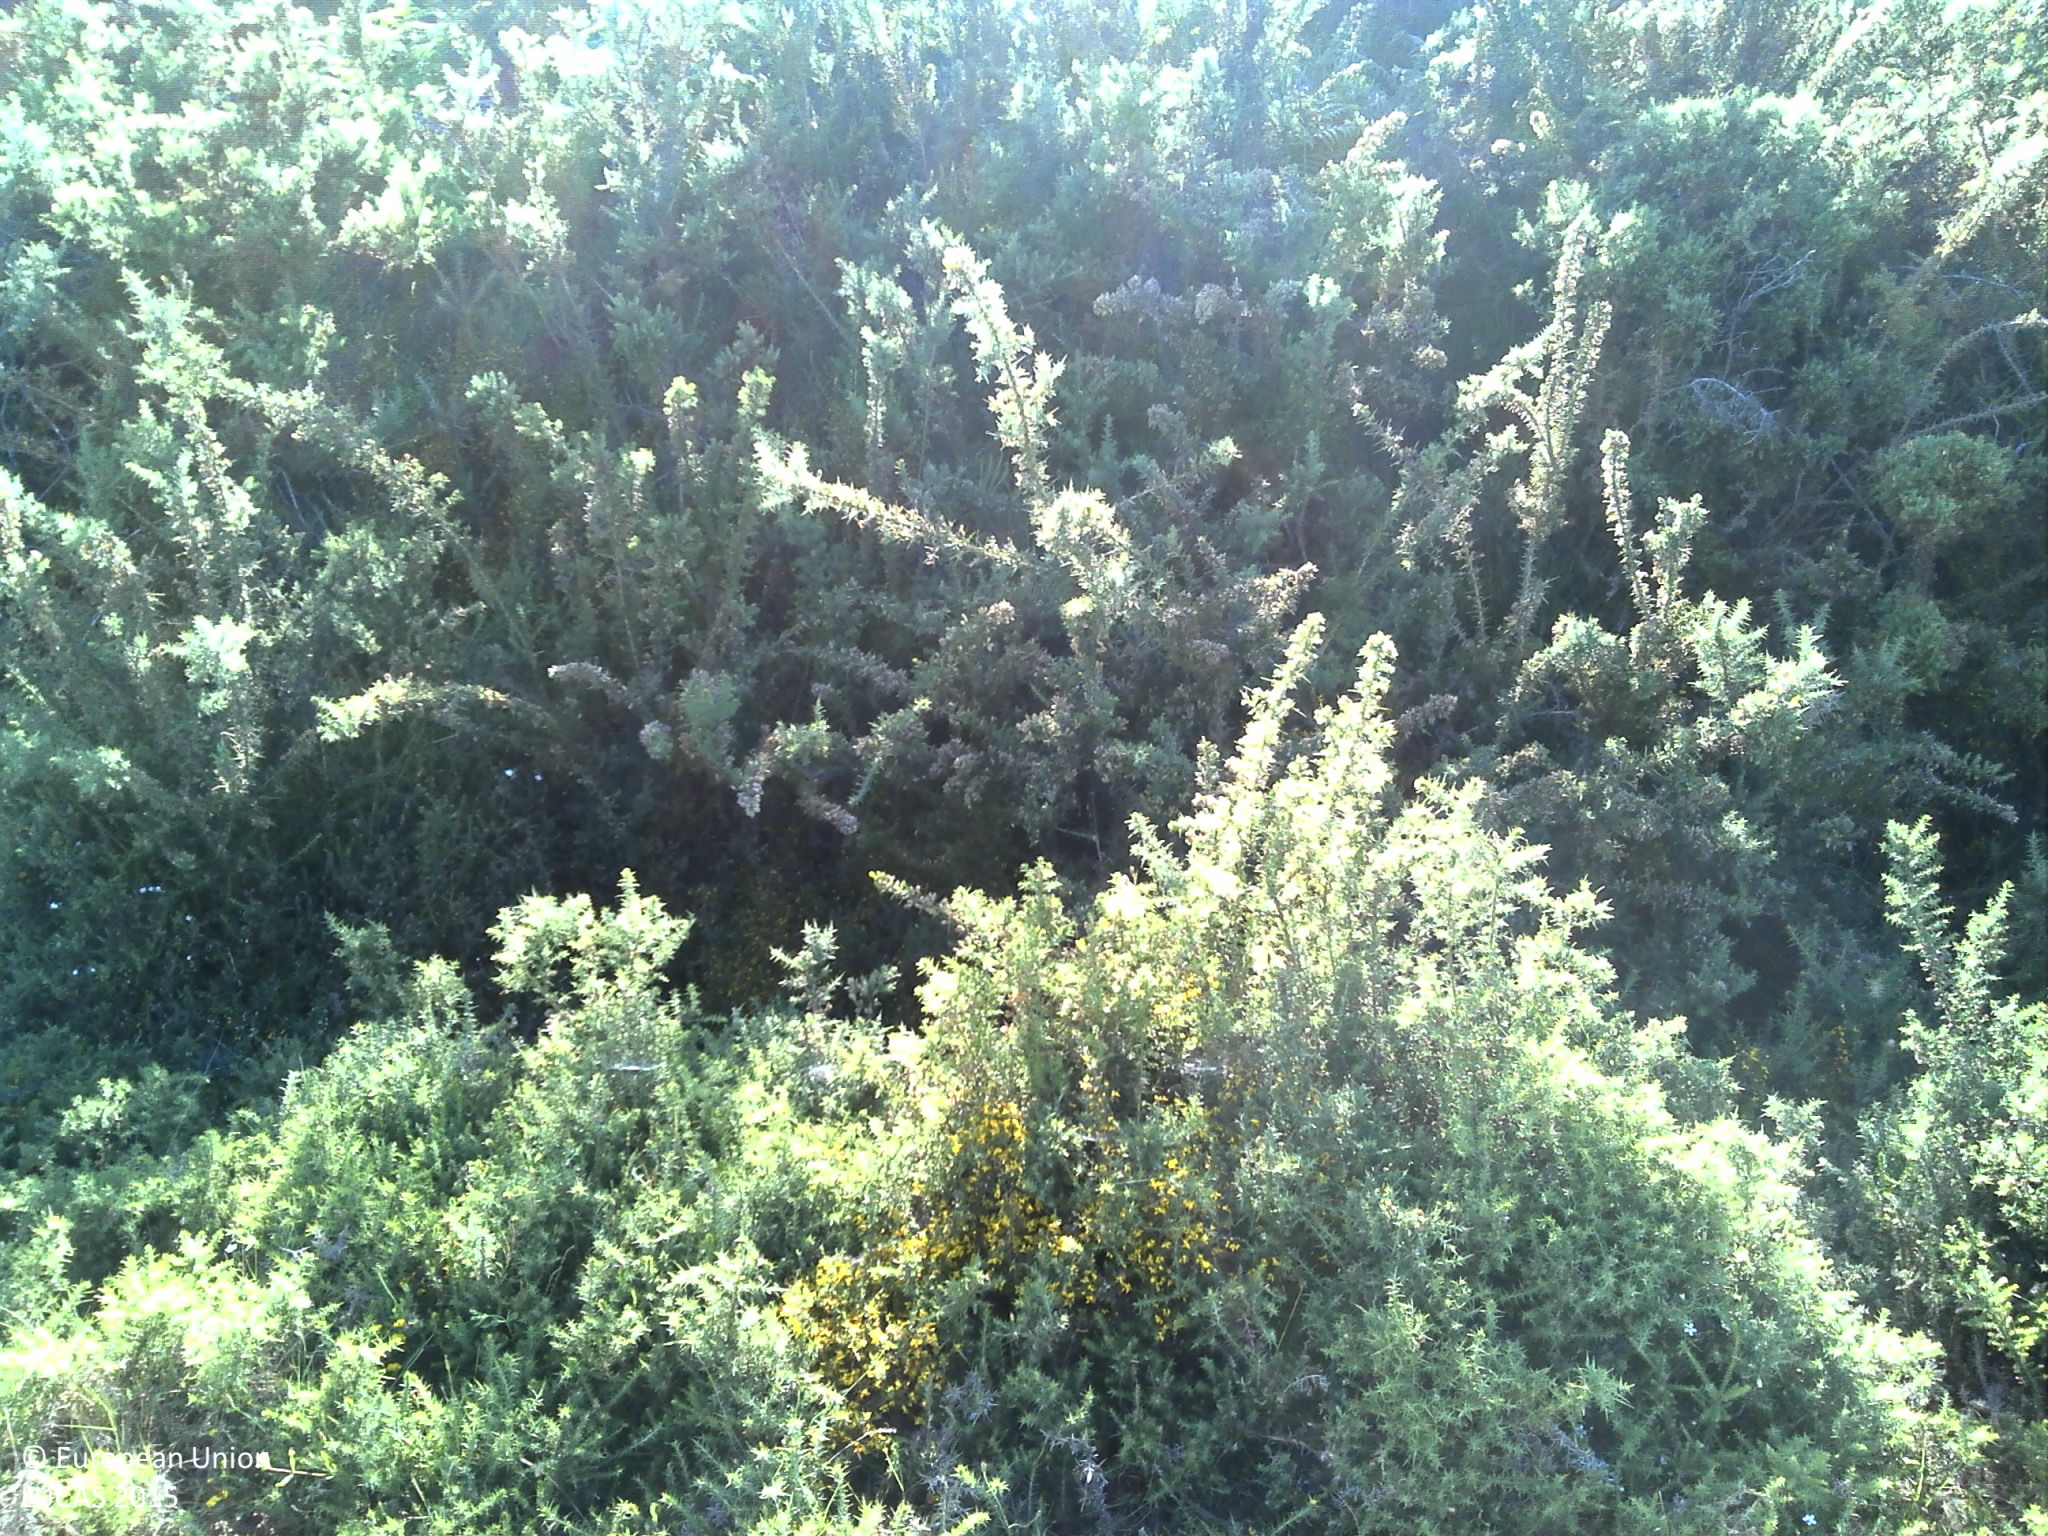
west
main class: Shrubland
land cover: Shrubland without tree cover
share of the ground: > 75 %
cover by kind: shrubs 80 %, herbaceous plants 15 %, unconsolidated bare surface 5 %
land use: Semi-natural and natural areas not in use
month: May
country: PT
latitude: 41.7281
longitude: -8.5911
